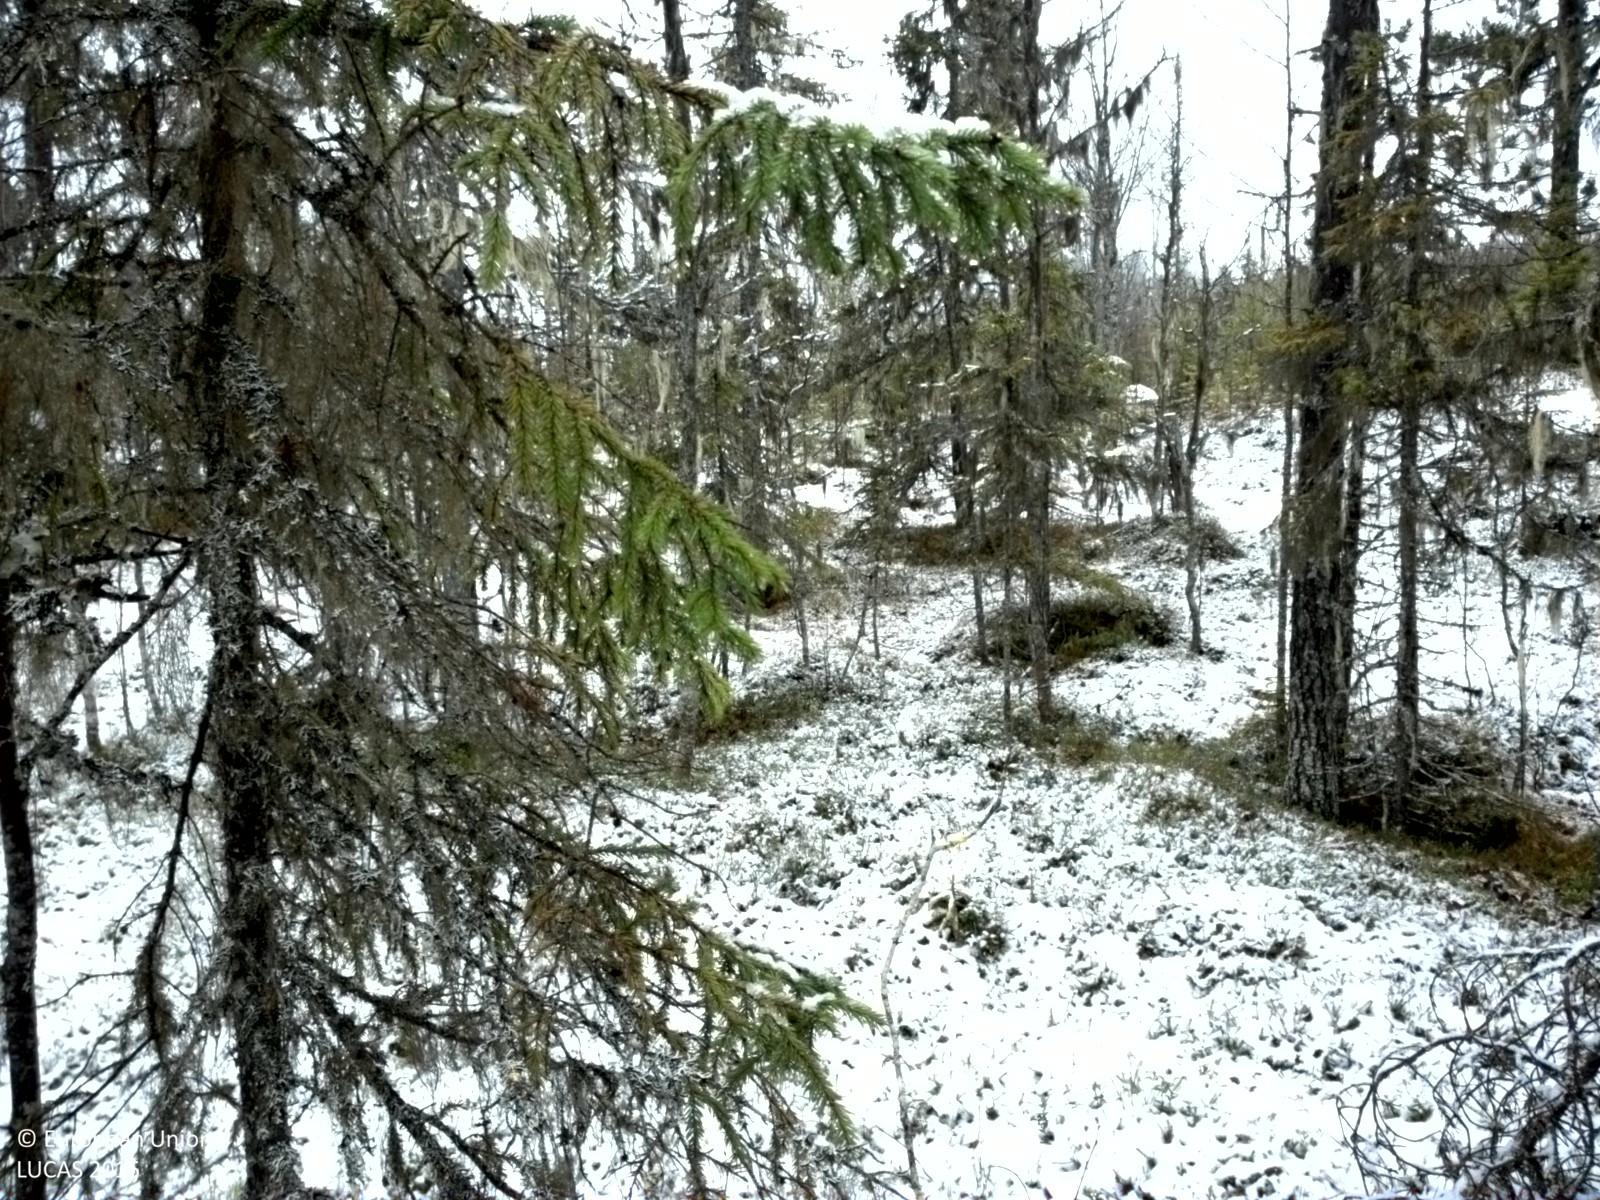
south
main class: Woodland
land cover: Spruce dominated mixed woodland
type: boreal forest
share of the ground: 25 - 50 %
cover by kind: shrubs 40 %, coniferous forest trees 30 %, lichens and mosses 15 %, broadleaved forest trees 10 %, herbaceous plants 5 %
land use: Forestry
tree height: > 5 m
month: November
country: SE
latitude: 63.9933
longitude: 16.0425
